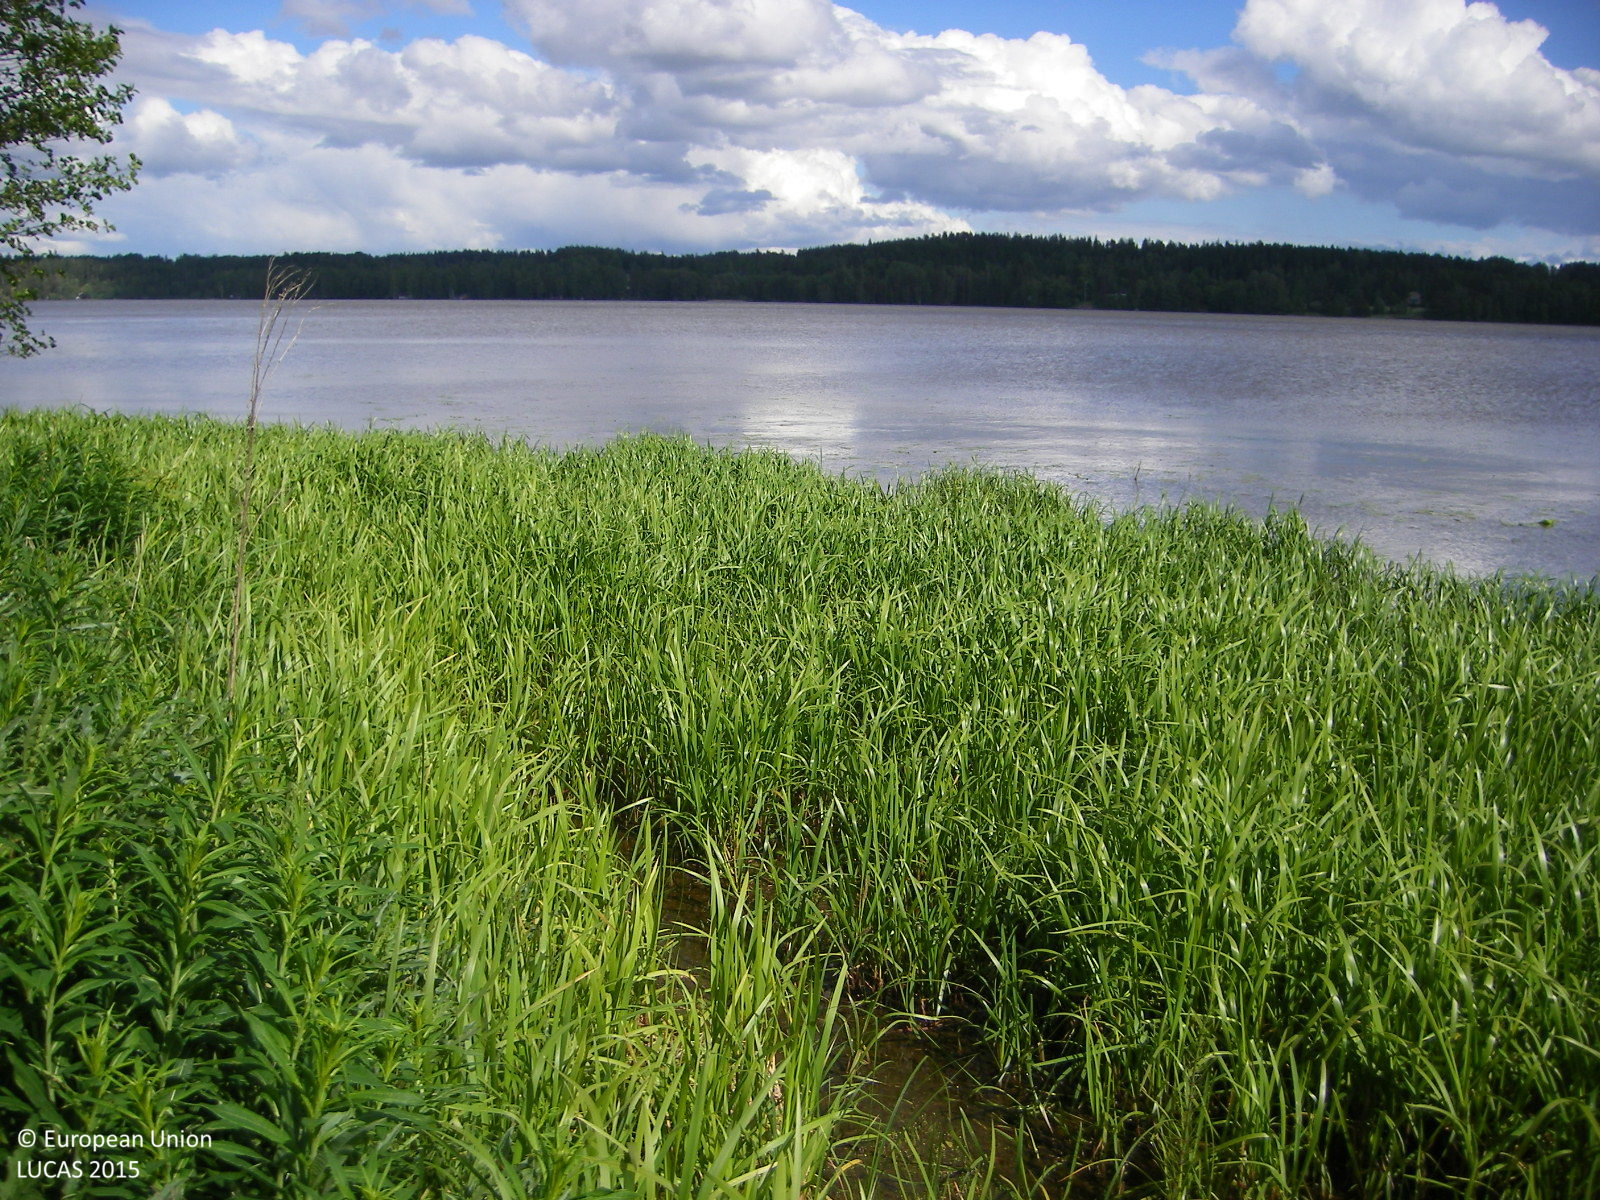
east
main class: Grassland
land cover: Spontaneously vegetated surfaces
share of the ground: > 75 %
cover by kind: herbaceous plants 100 %
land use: Semi-natural and natural areas not in use
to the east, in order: Spontaneously vegetated surfaces; Inland marshes; Inland fresh water bodies
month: June
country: FI
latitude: 60.3432
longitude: 24.1416
